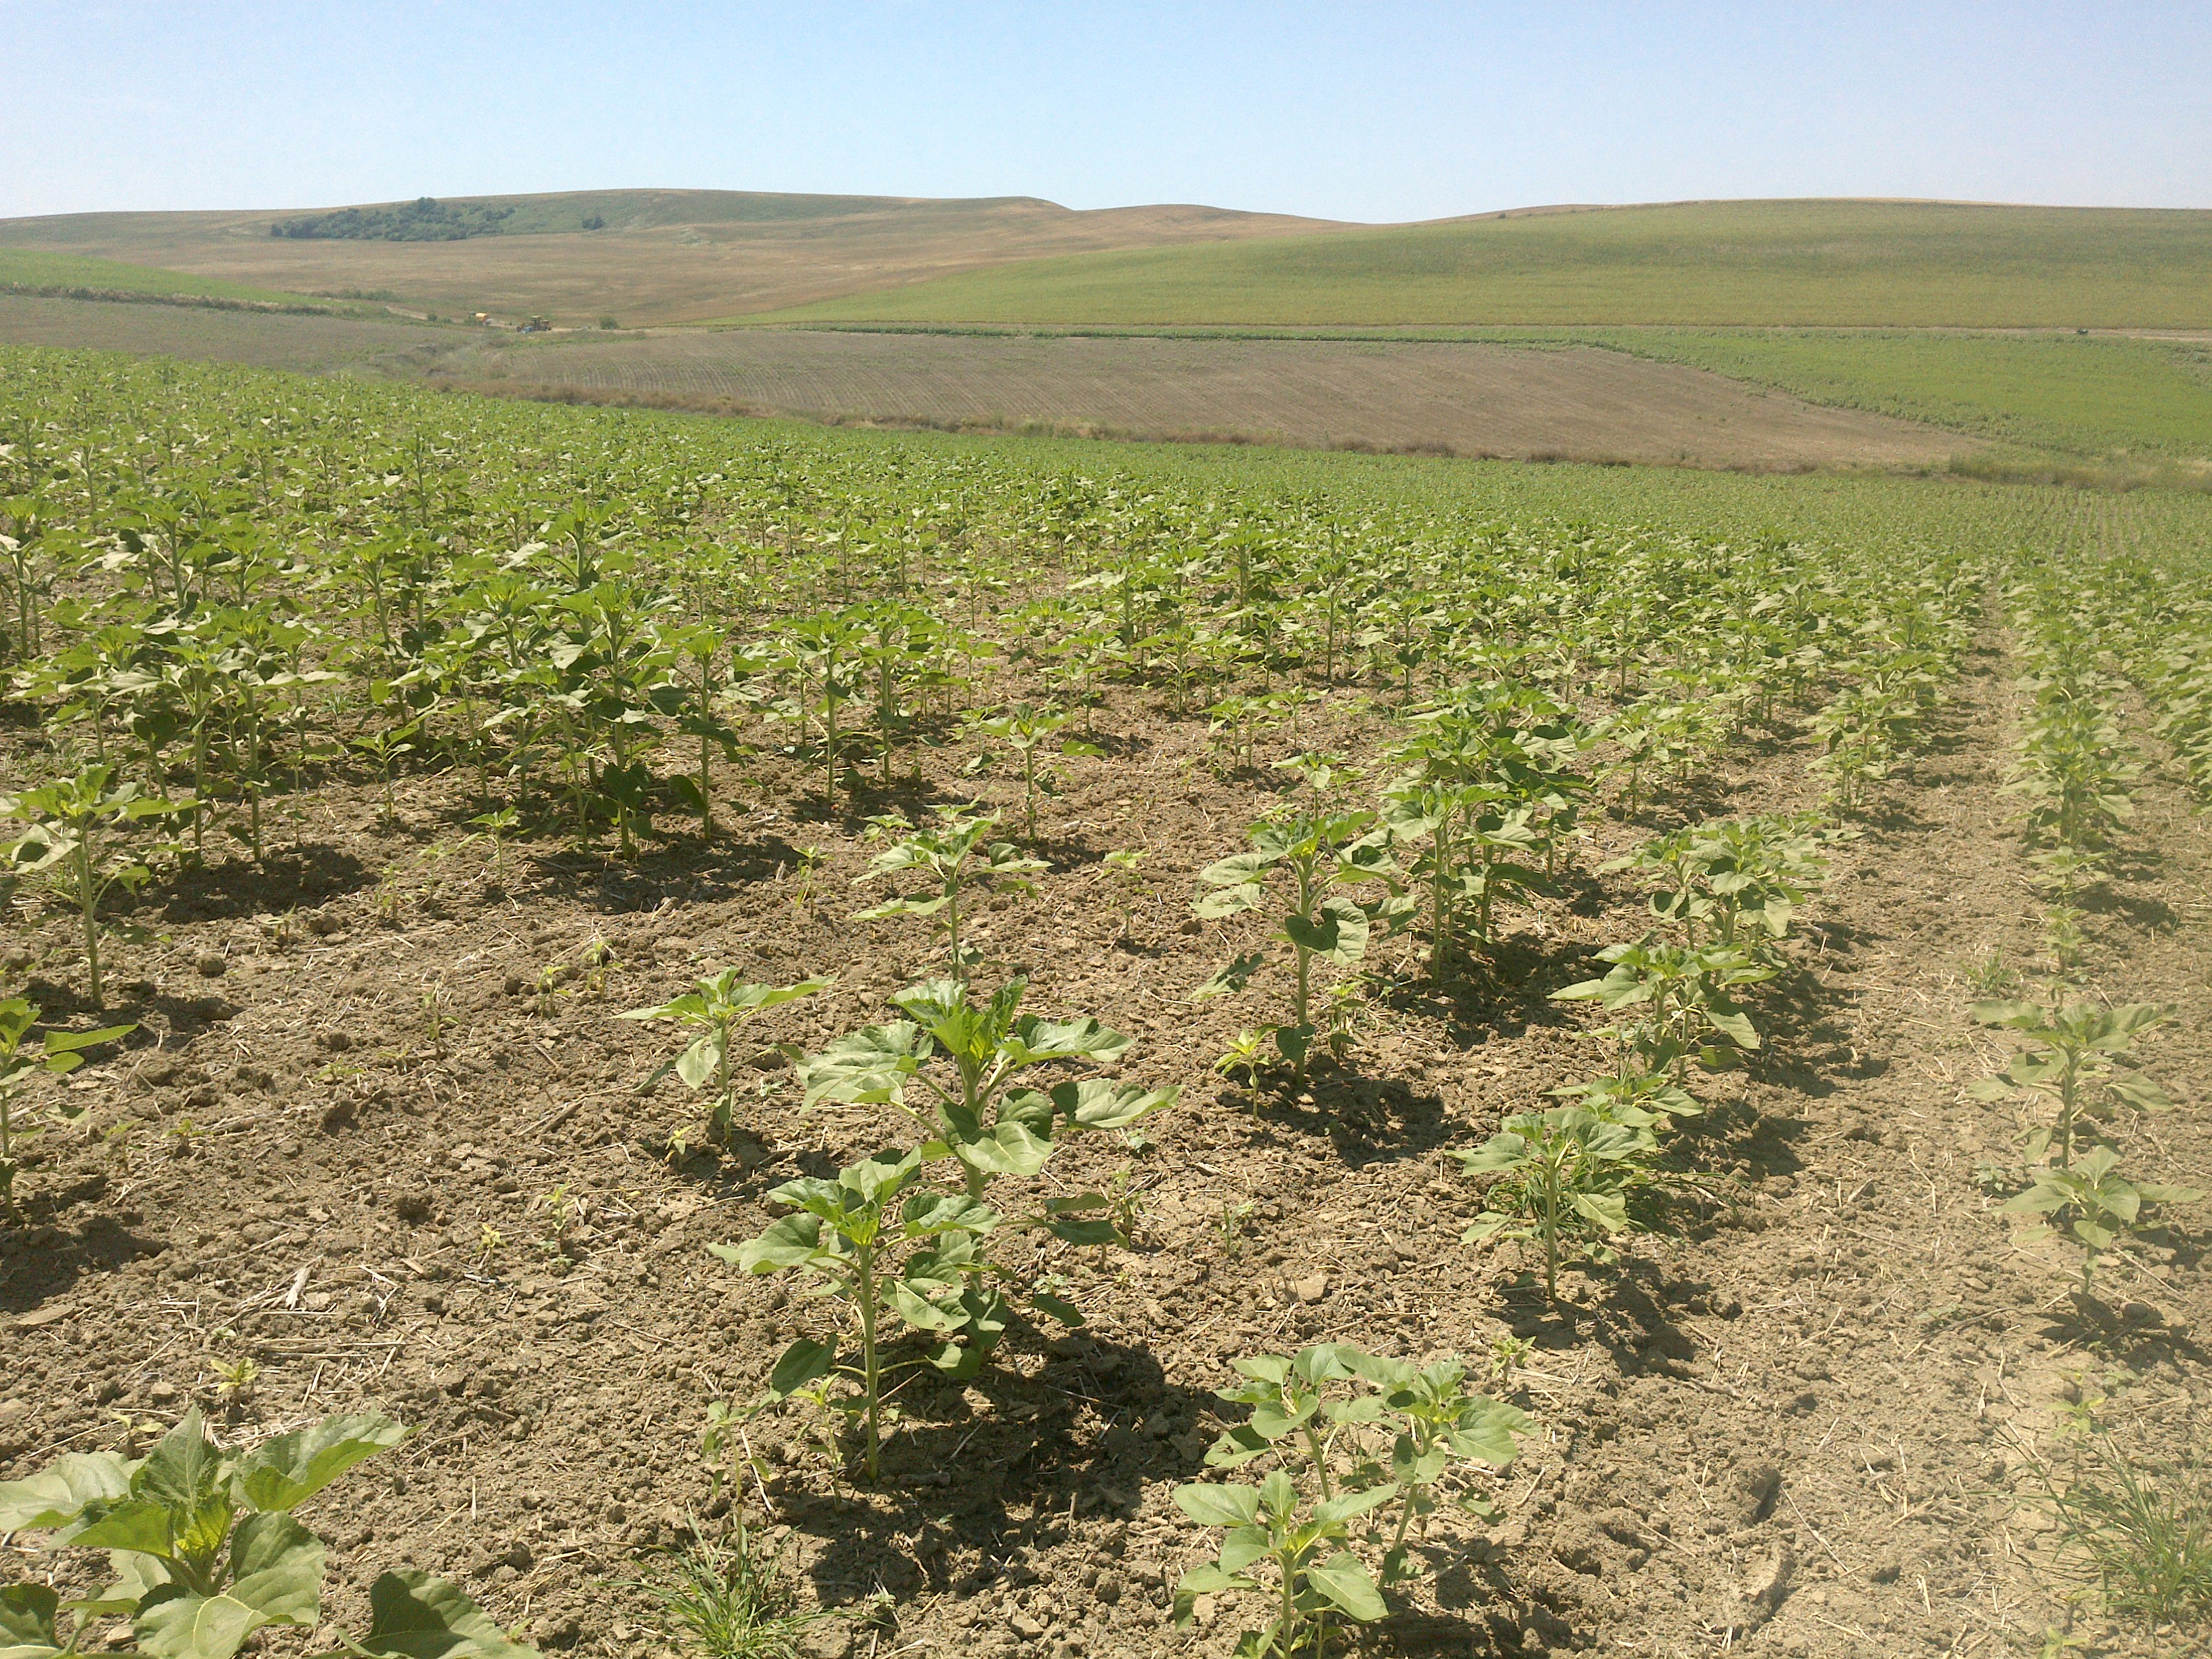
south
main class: Cropland
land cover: Sunflower
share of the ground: > 75 %
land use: Agriculture (excluding fallow land and kitchen gardens)
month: May
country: ES
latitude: 37.8548
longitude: -4.6625
